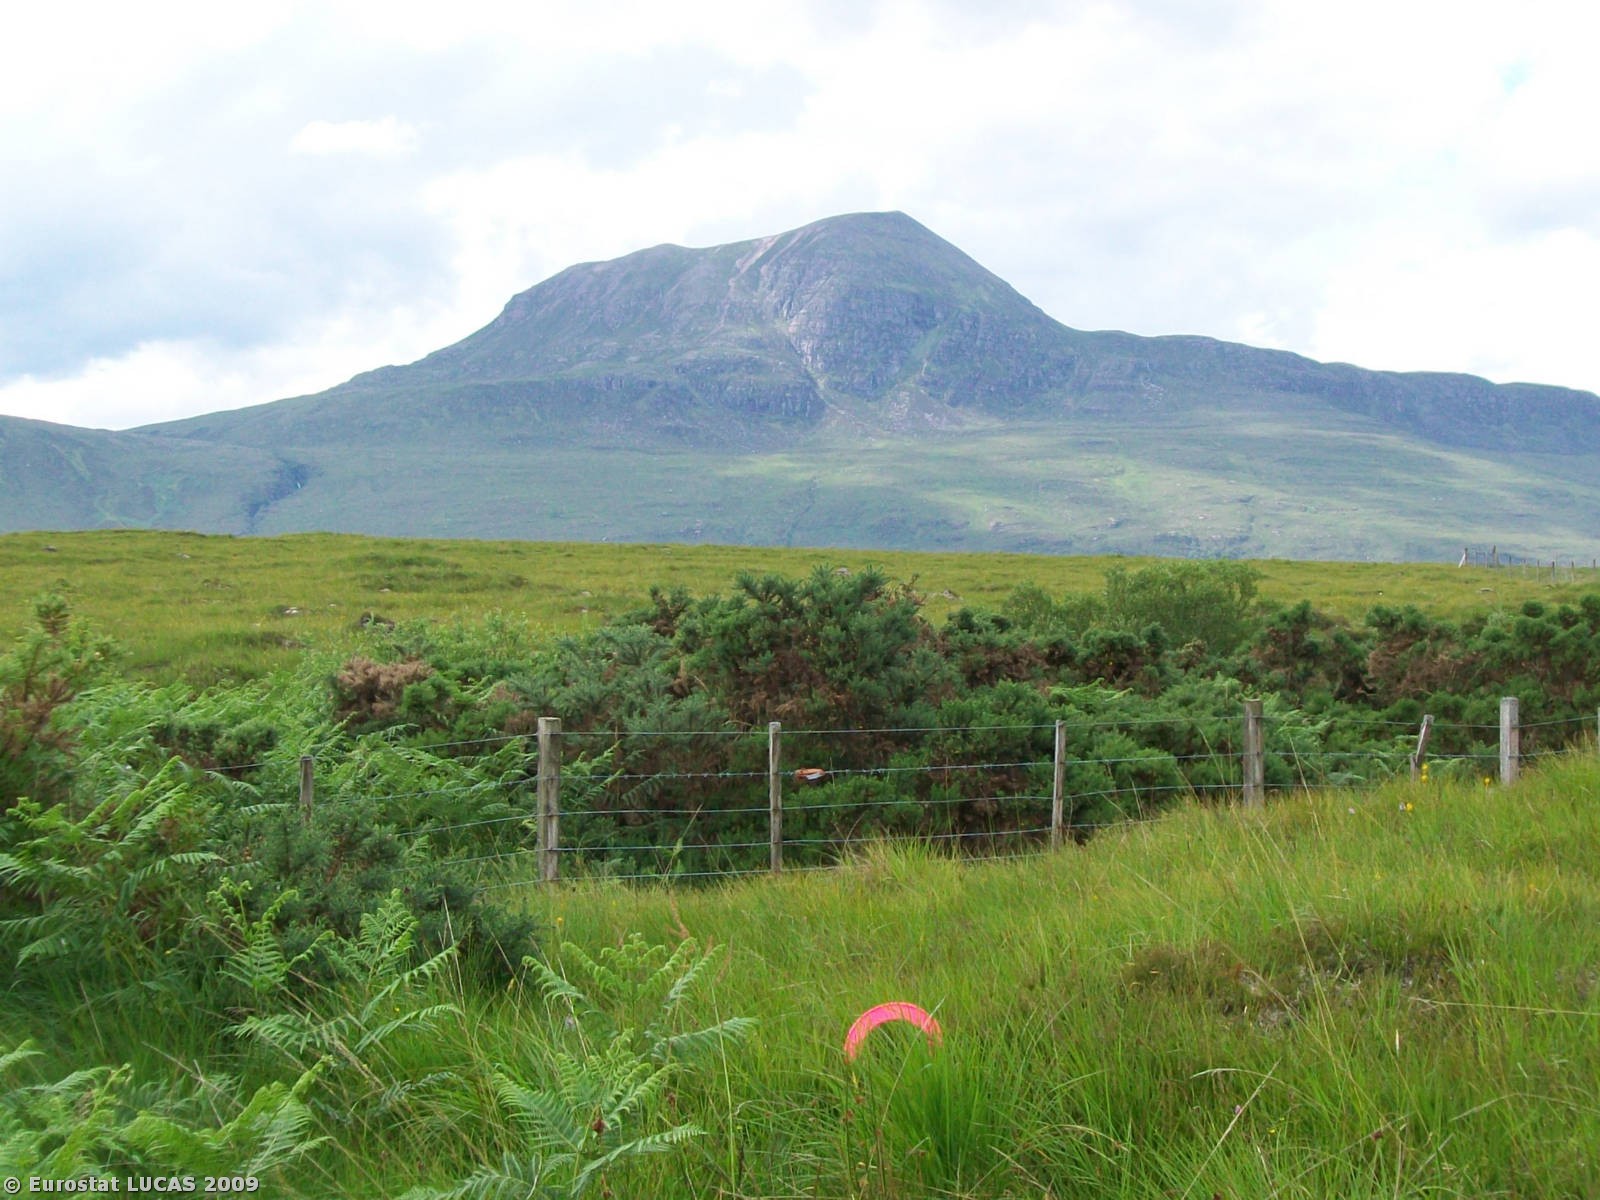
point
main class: Shrubland
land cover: Shrubland without tree cover
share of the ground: > 75 %
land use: Holiday camps
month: July
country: GB
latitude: 57.8724
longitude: -5.2634
